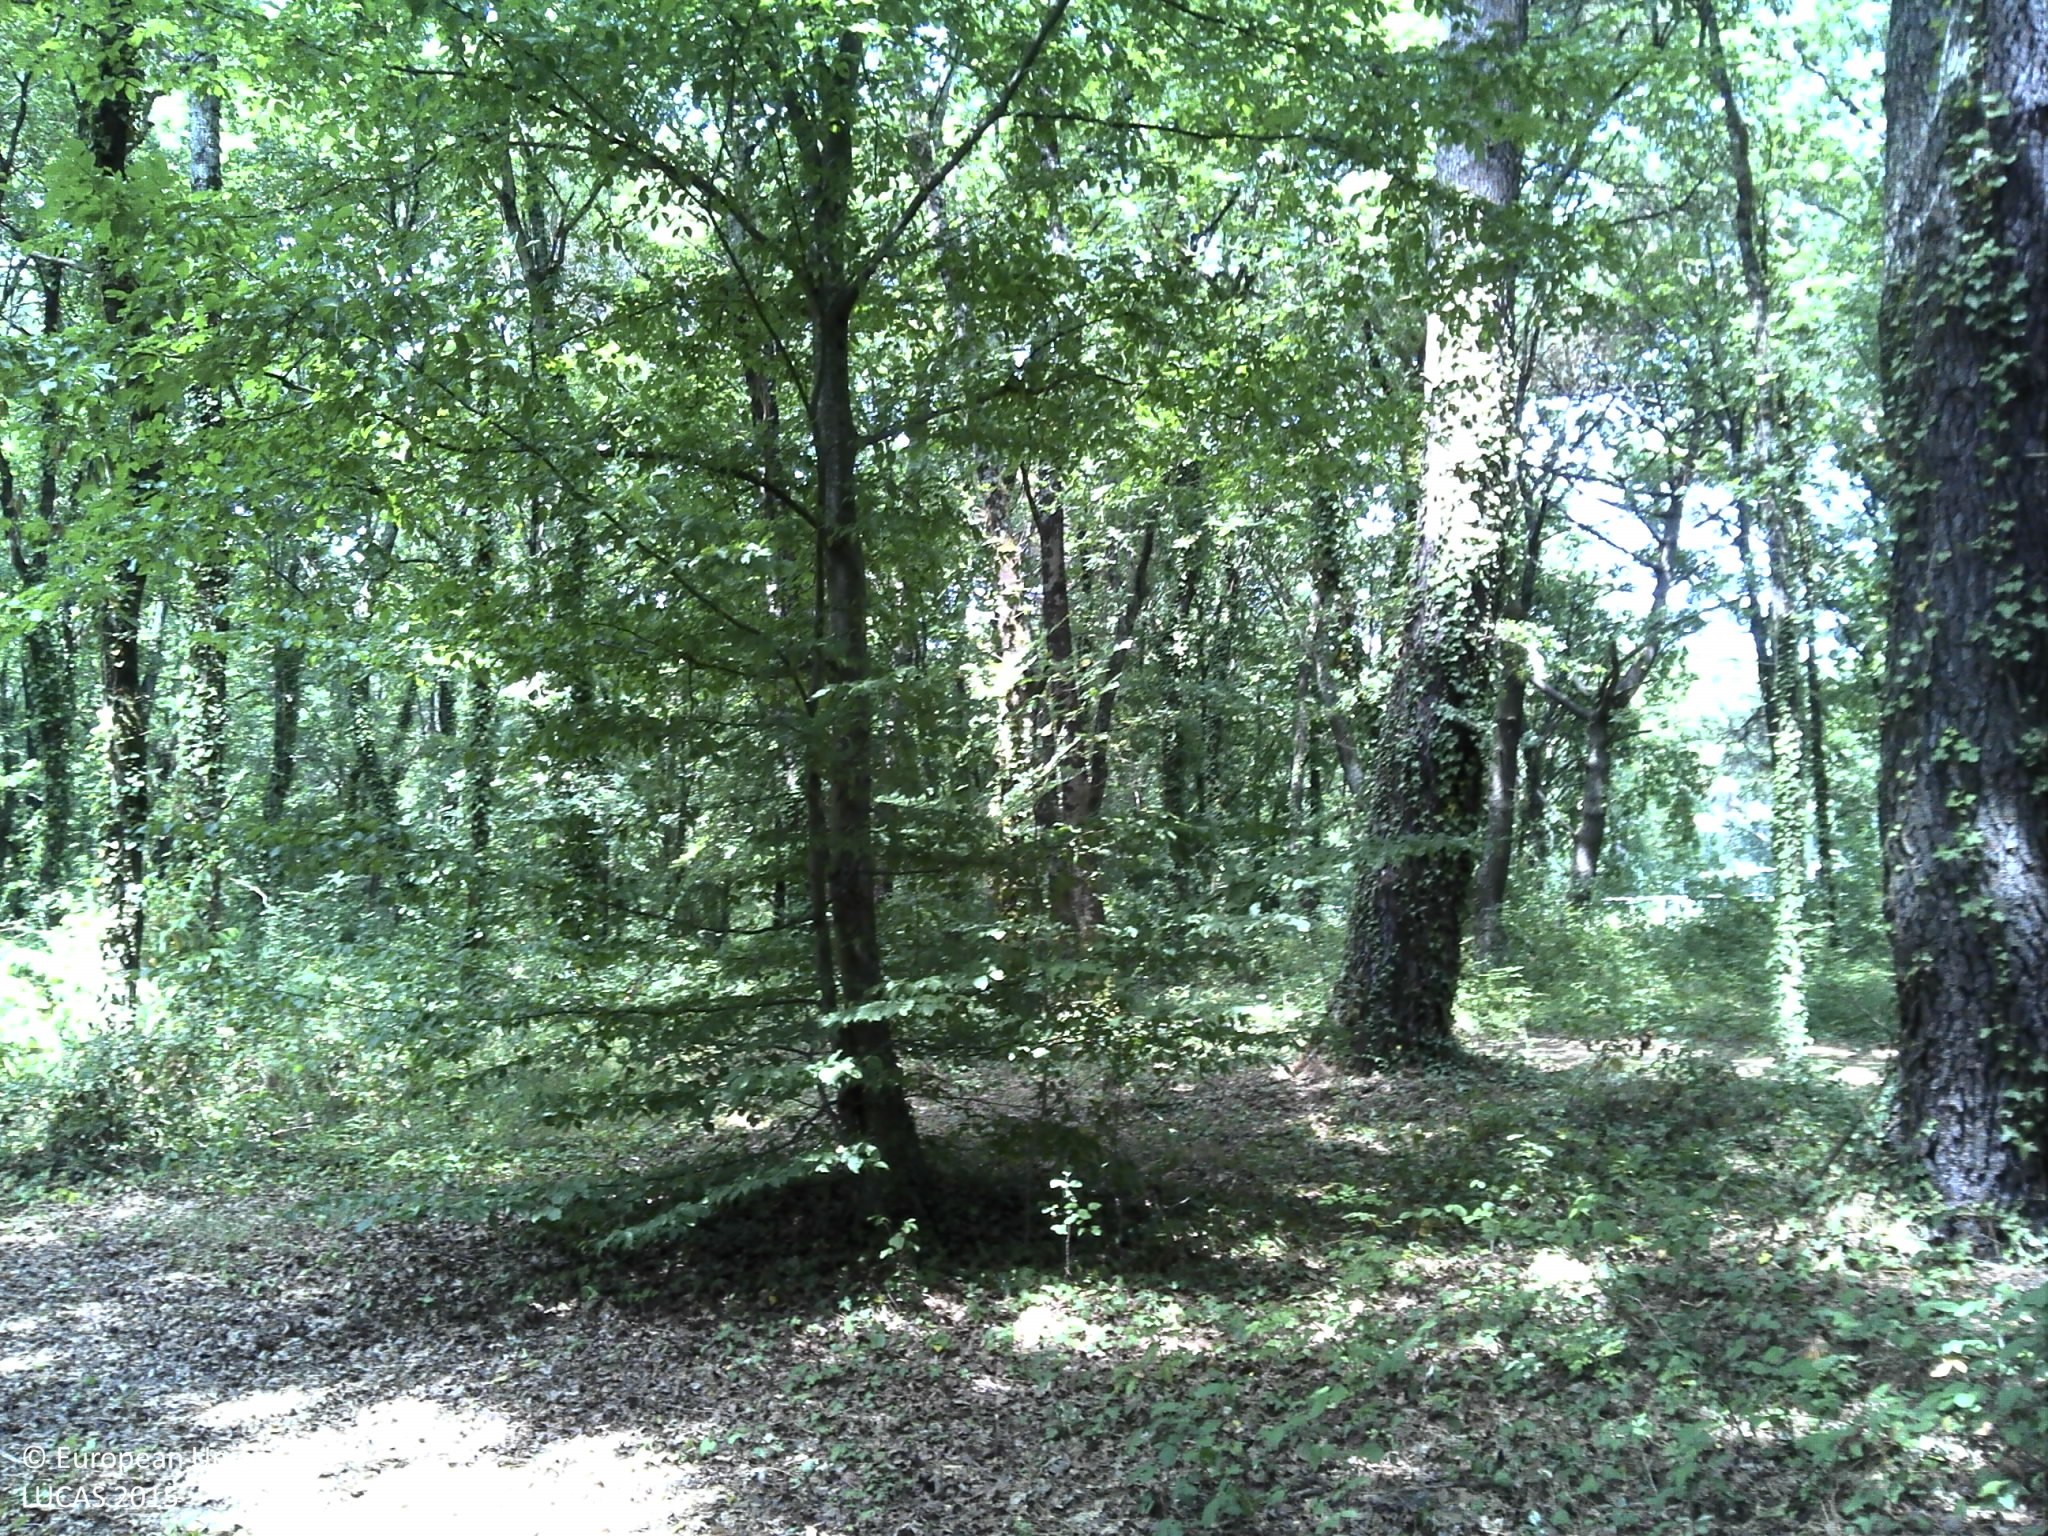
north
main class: Woodland
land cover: Broadleaved woodland
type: mesophytic deciduous forest
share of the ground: > 75 %
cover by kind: broadleaved forest trees 70 %, unconsolidated bare surface 15 %, herbaceous plants 10 %, coniferous forest trees 5 %
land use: Forestry
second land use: Sport
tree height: > 5 m
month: July
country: FR
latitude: 44.7878
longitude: -0.5975
